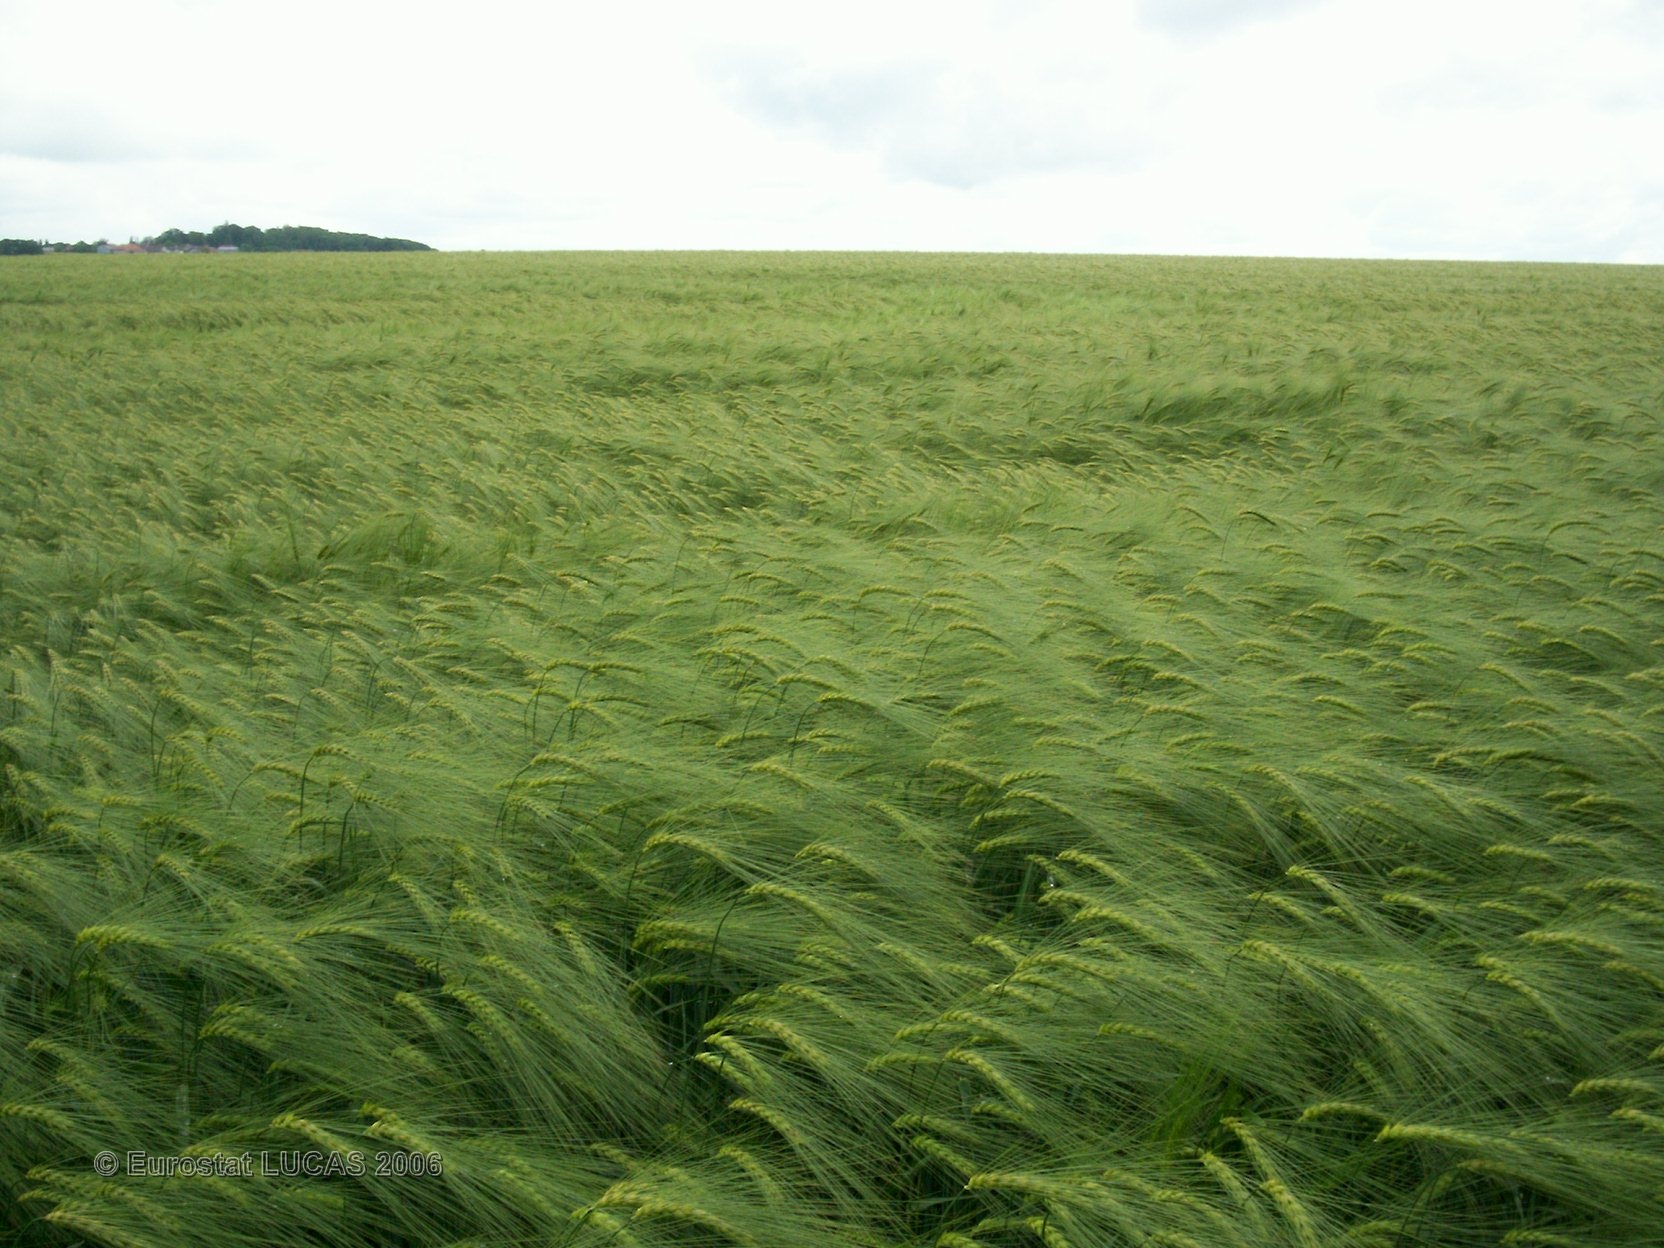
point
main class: Cropland
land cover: Barley
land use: Agriculture (excluding fallow land and kitchen gardens)
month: May
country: FR
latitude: 48.2494
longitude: 4.5164
